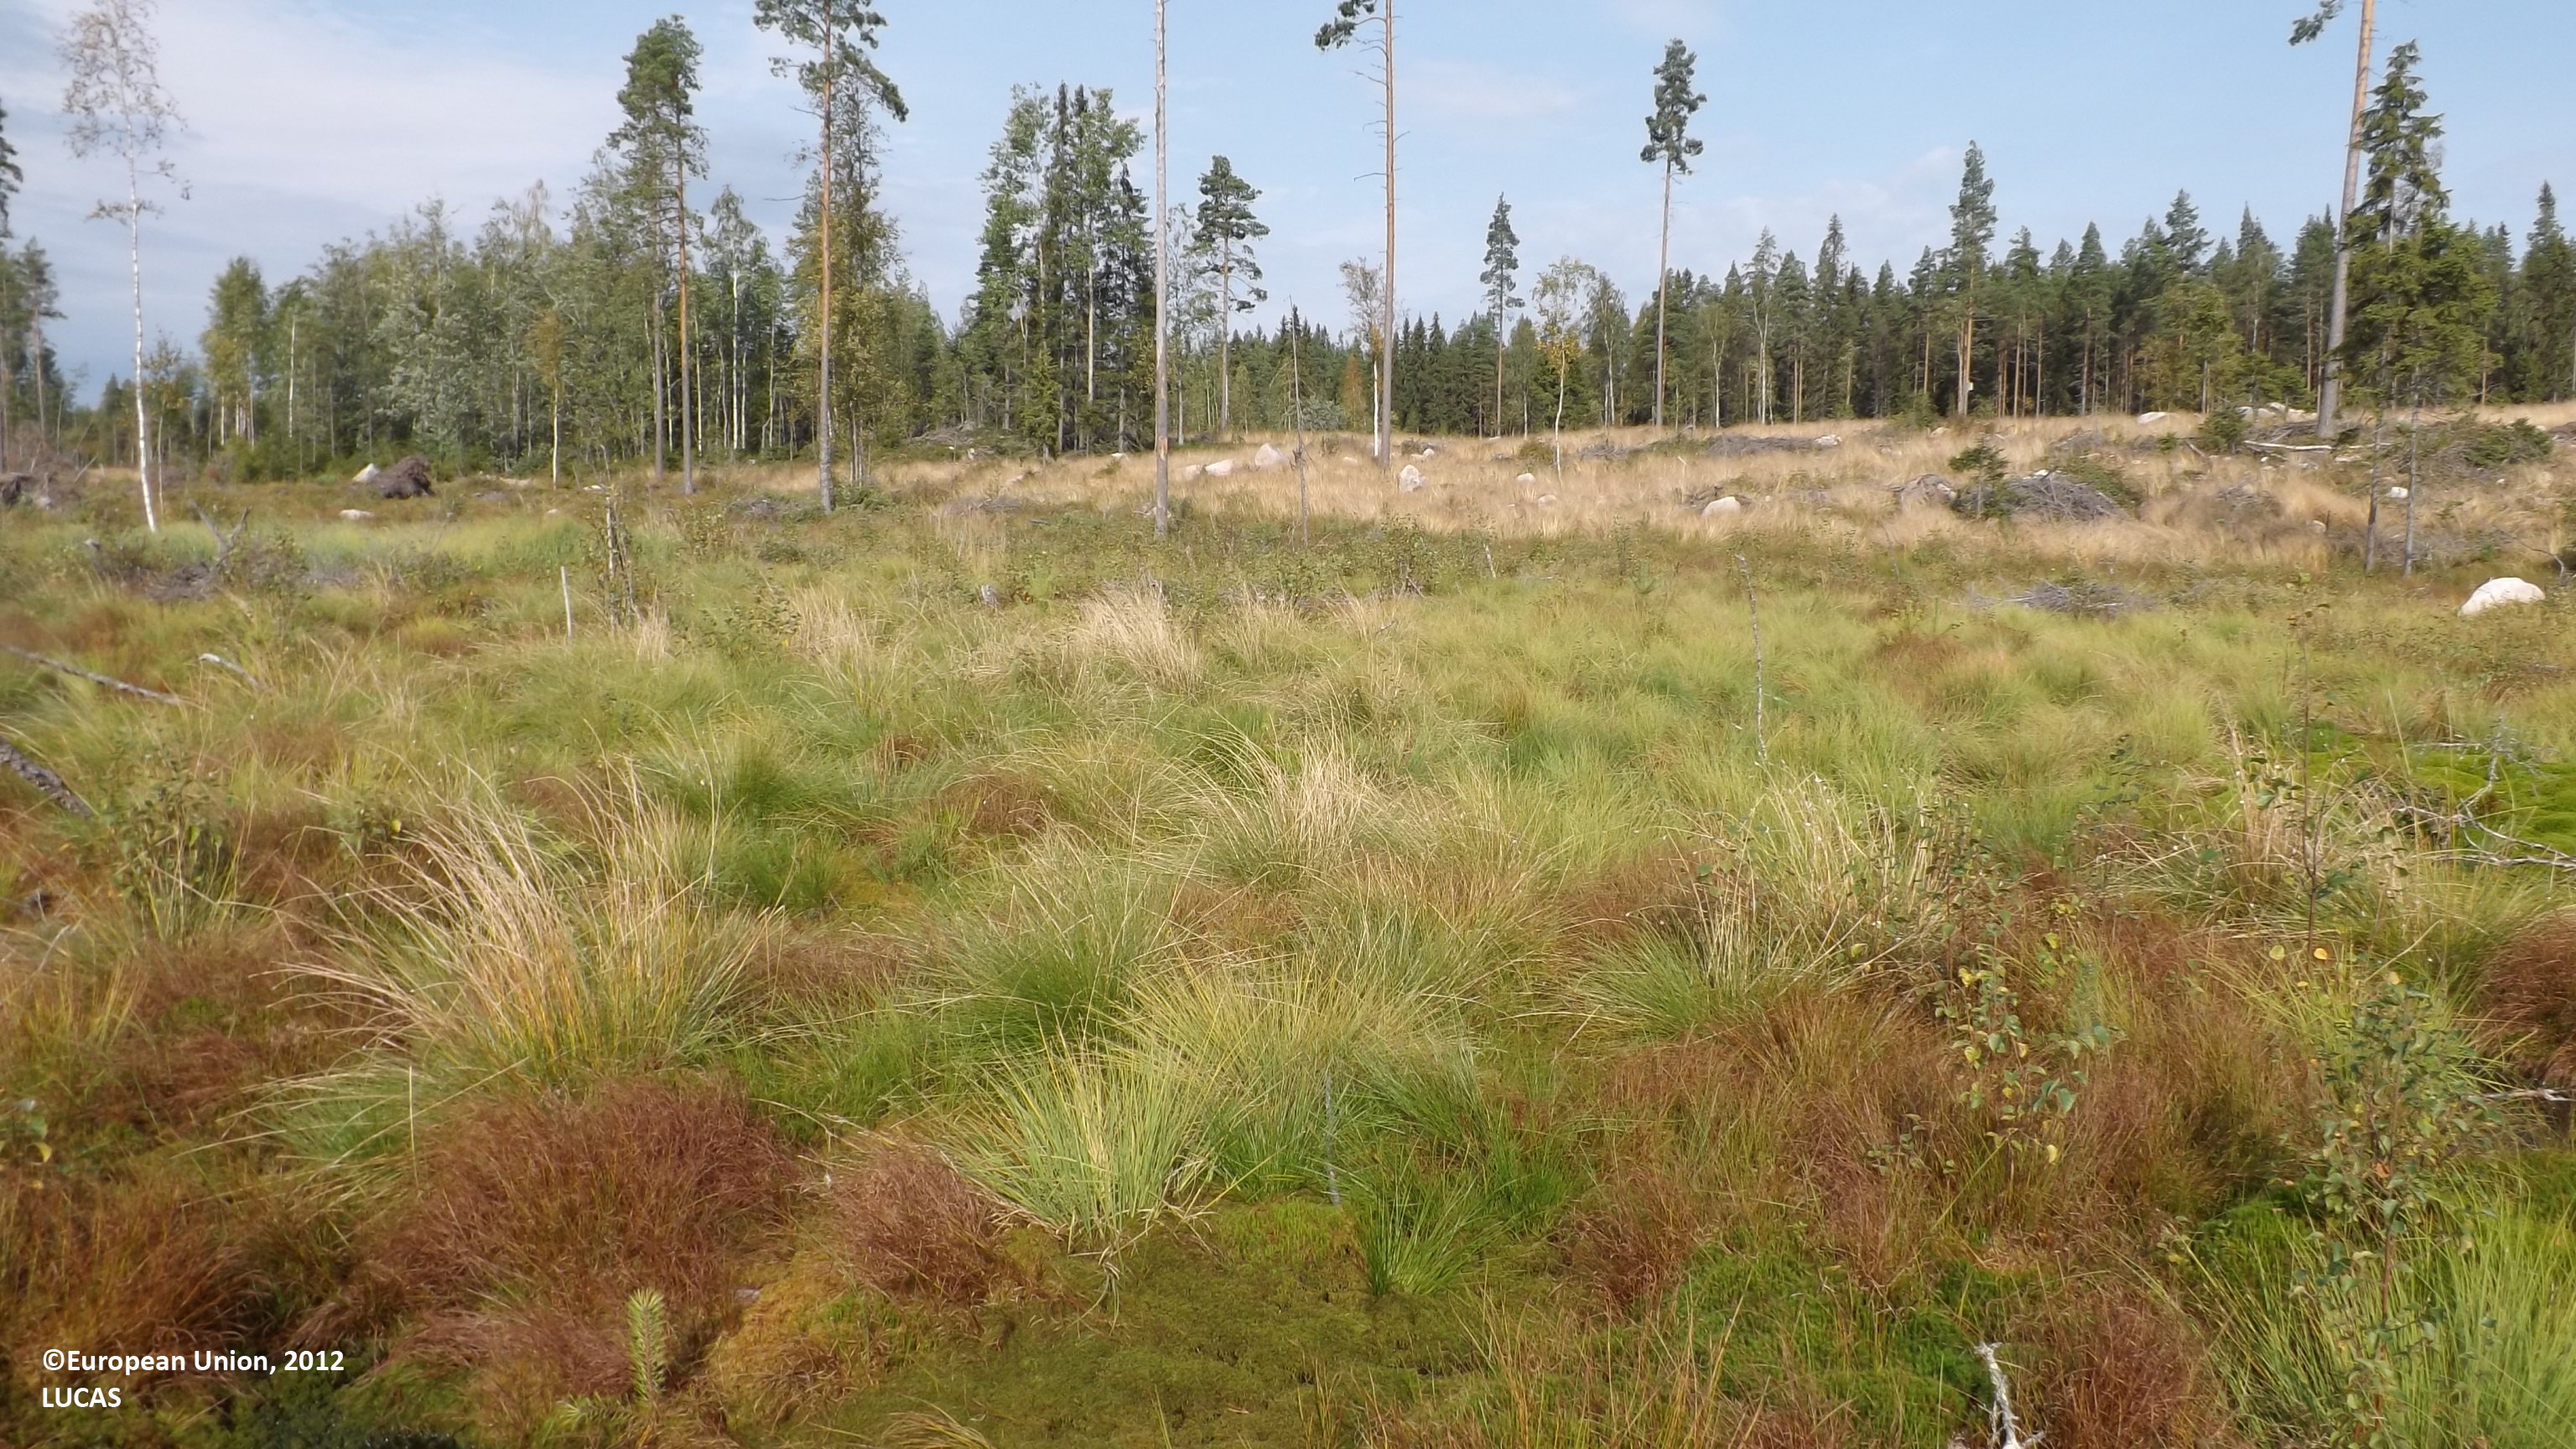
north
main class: Grassland
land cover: Grassland with sparse tree/shrub cover
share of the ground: 25 - 50 %
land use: Forestry
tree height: < 5 m
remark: Clear cut
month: August
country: FI
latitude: 63.7559
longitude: 23.5803
